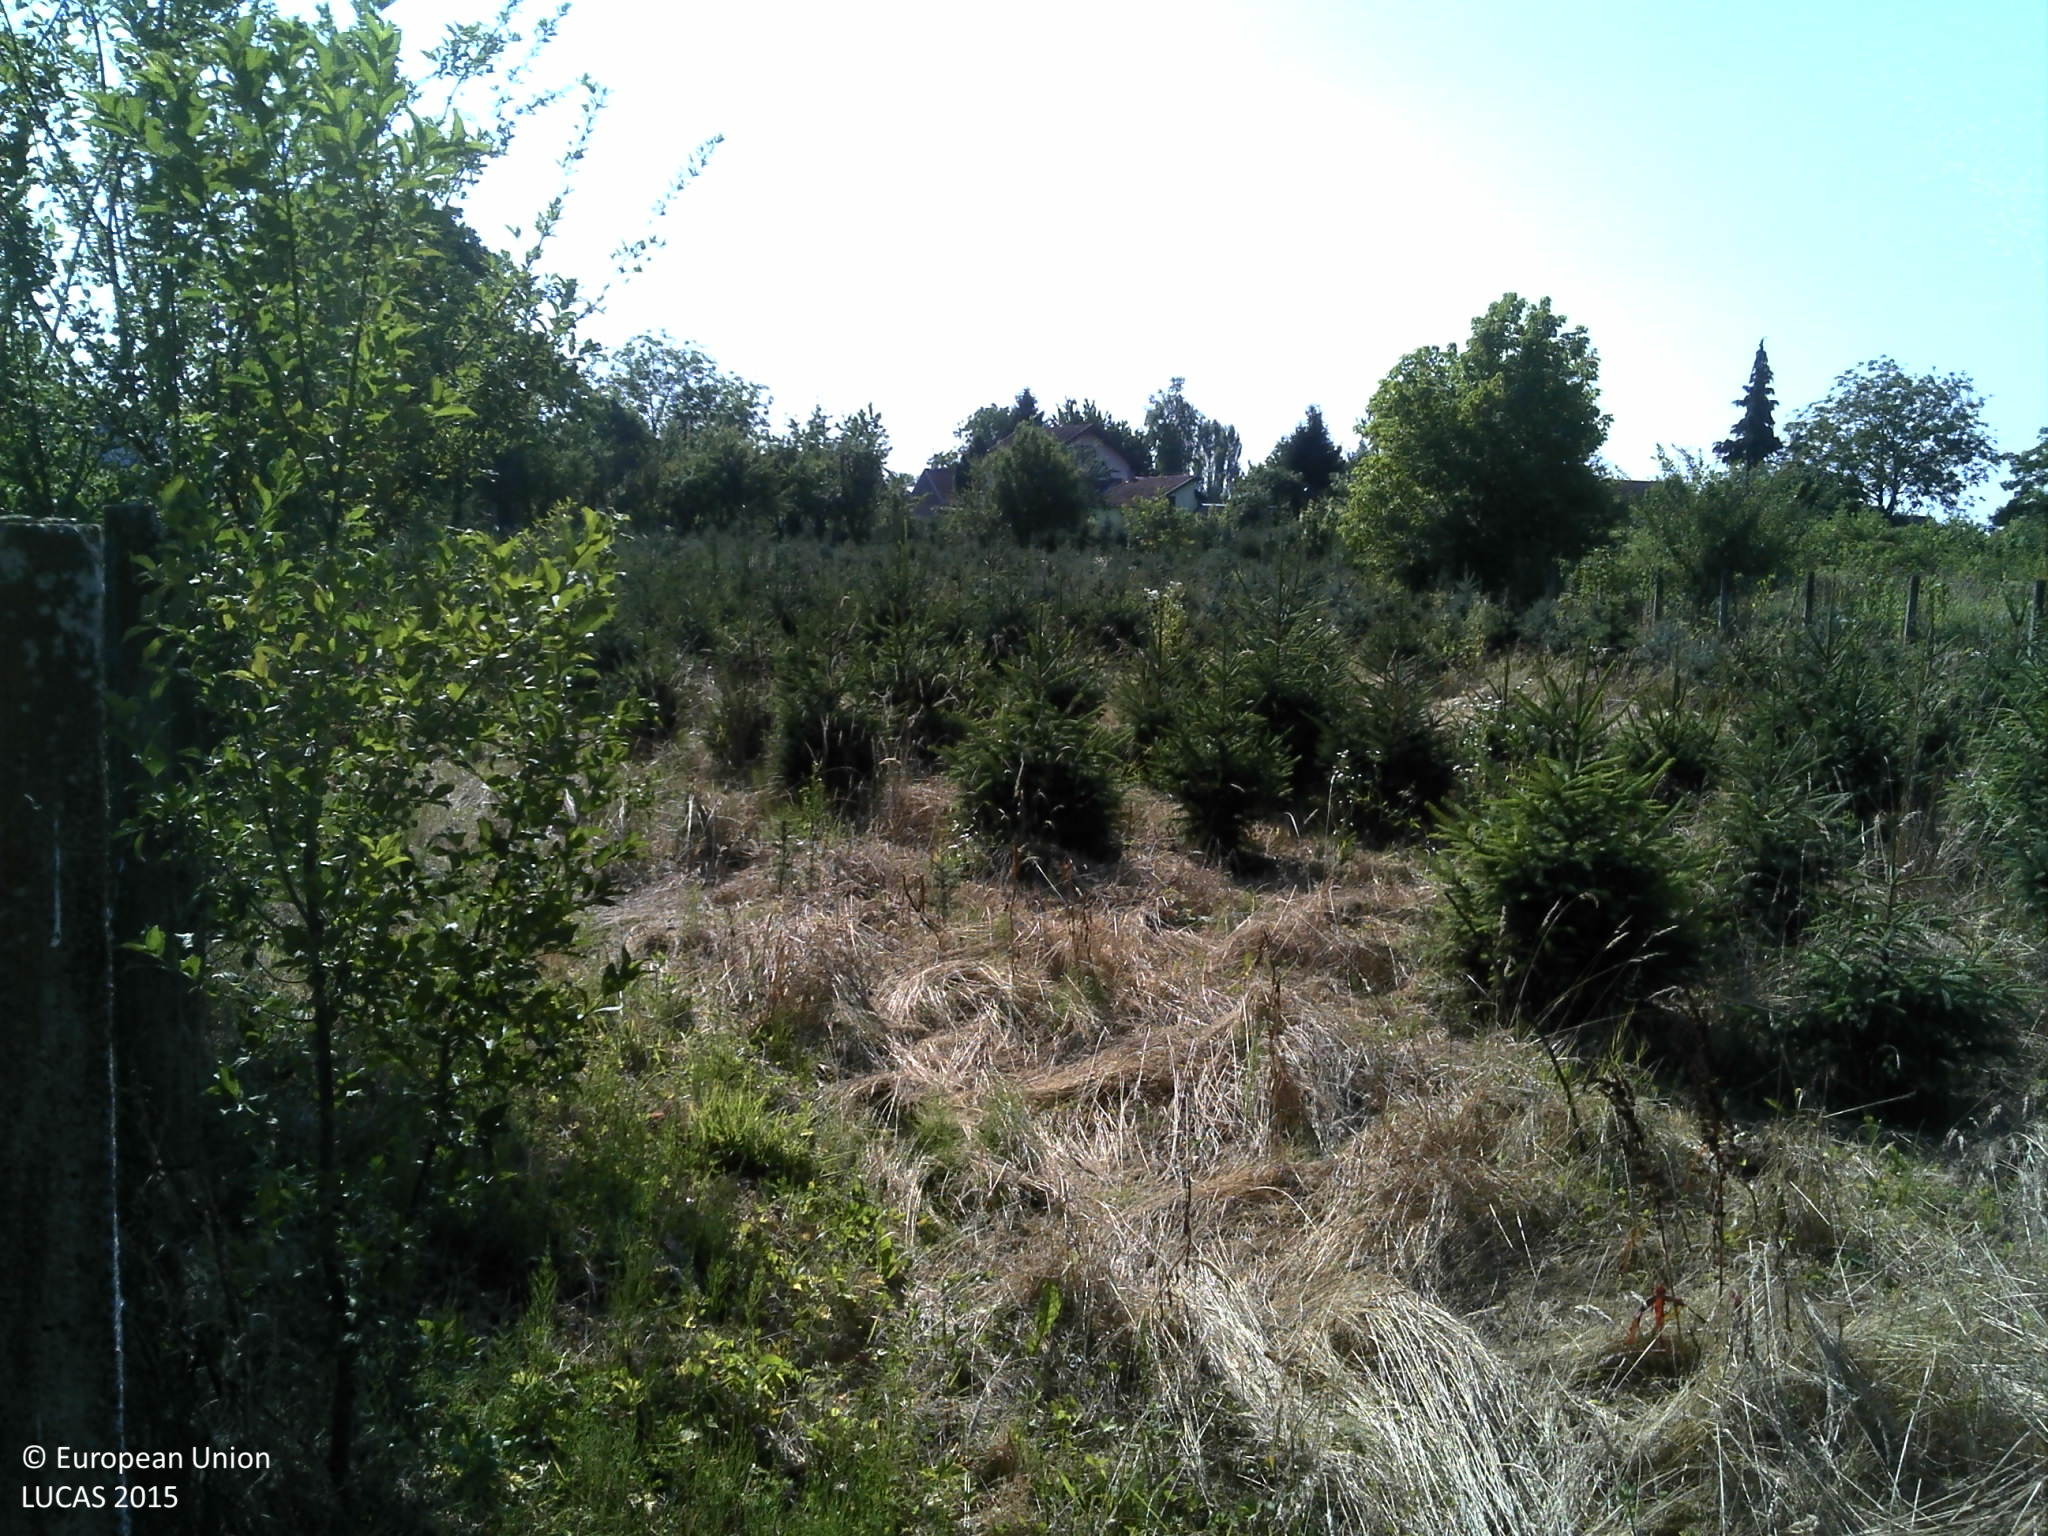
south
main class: Cropland
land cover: Nurseries
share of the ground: 10 - 25 %
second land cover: Spontaneously vegetated surfaces
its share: > 75 %
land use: Agriculture (excluding fallow land and kitchen gardens)
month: June
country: HR
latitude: 45.2462
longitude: 17.3768
